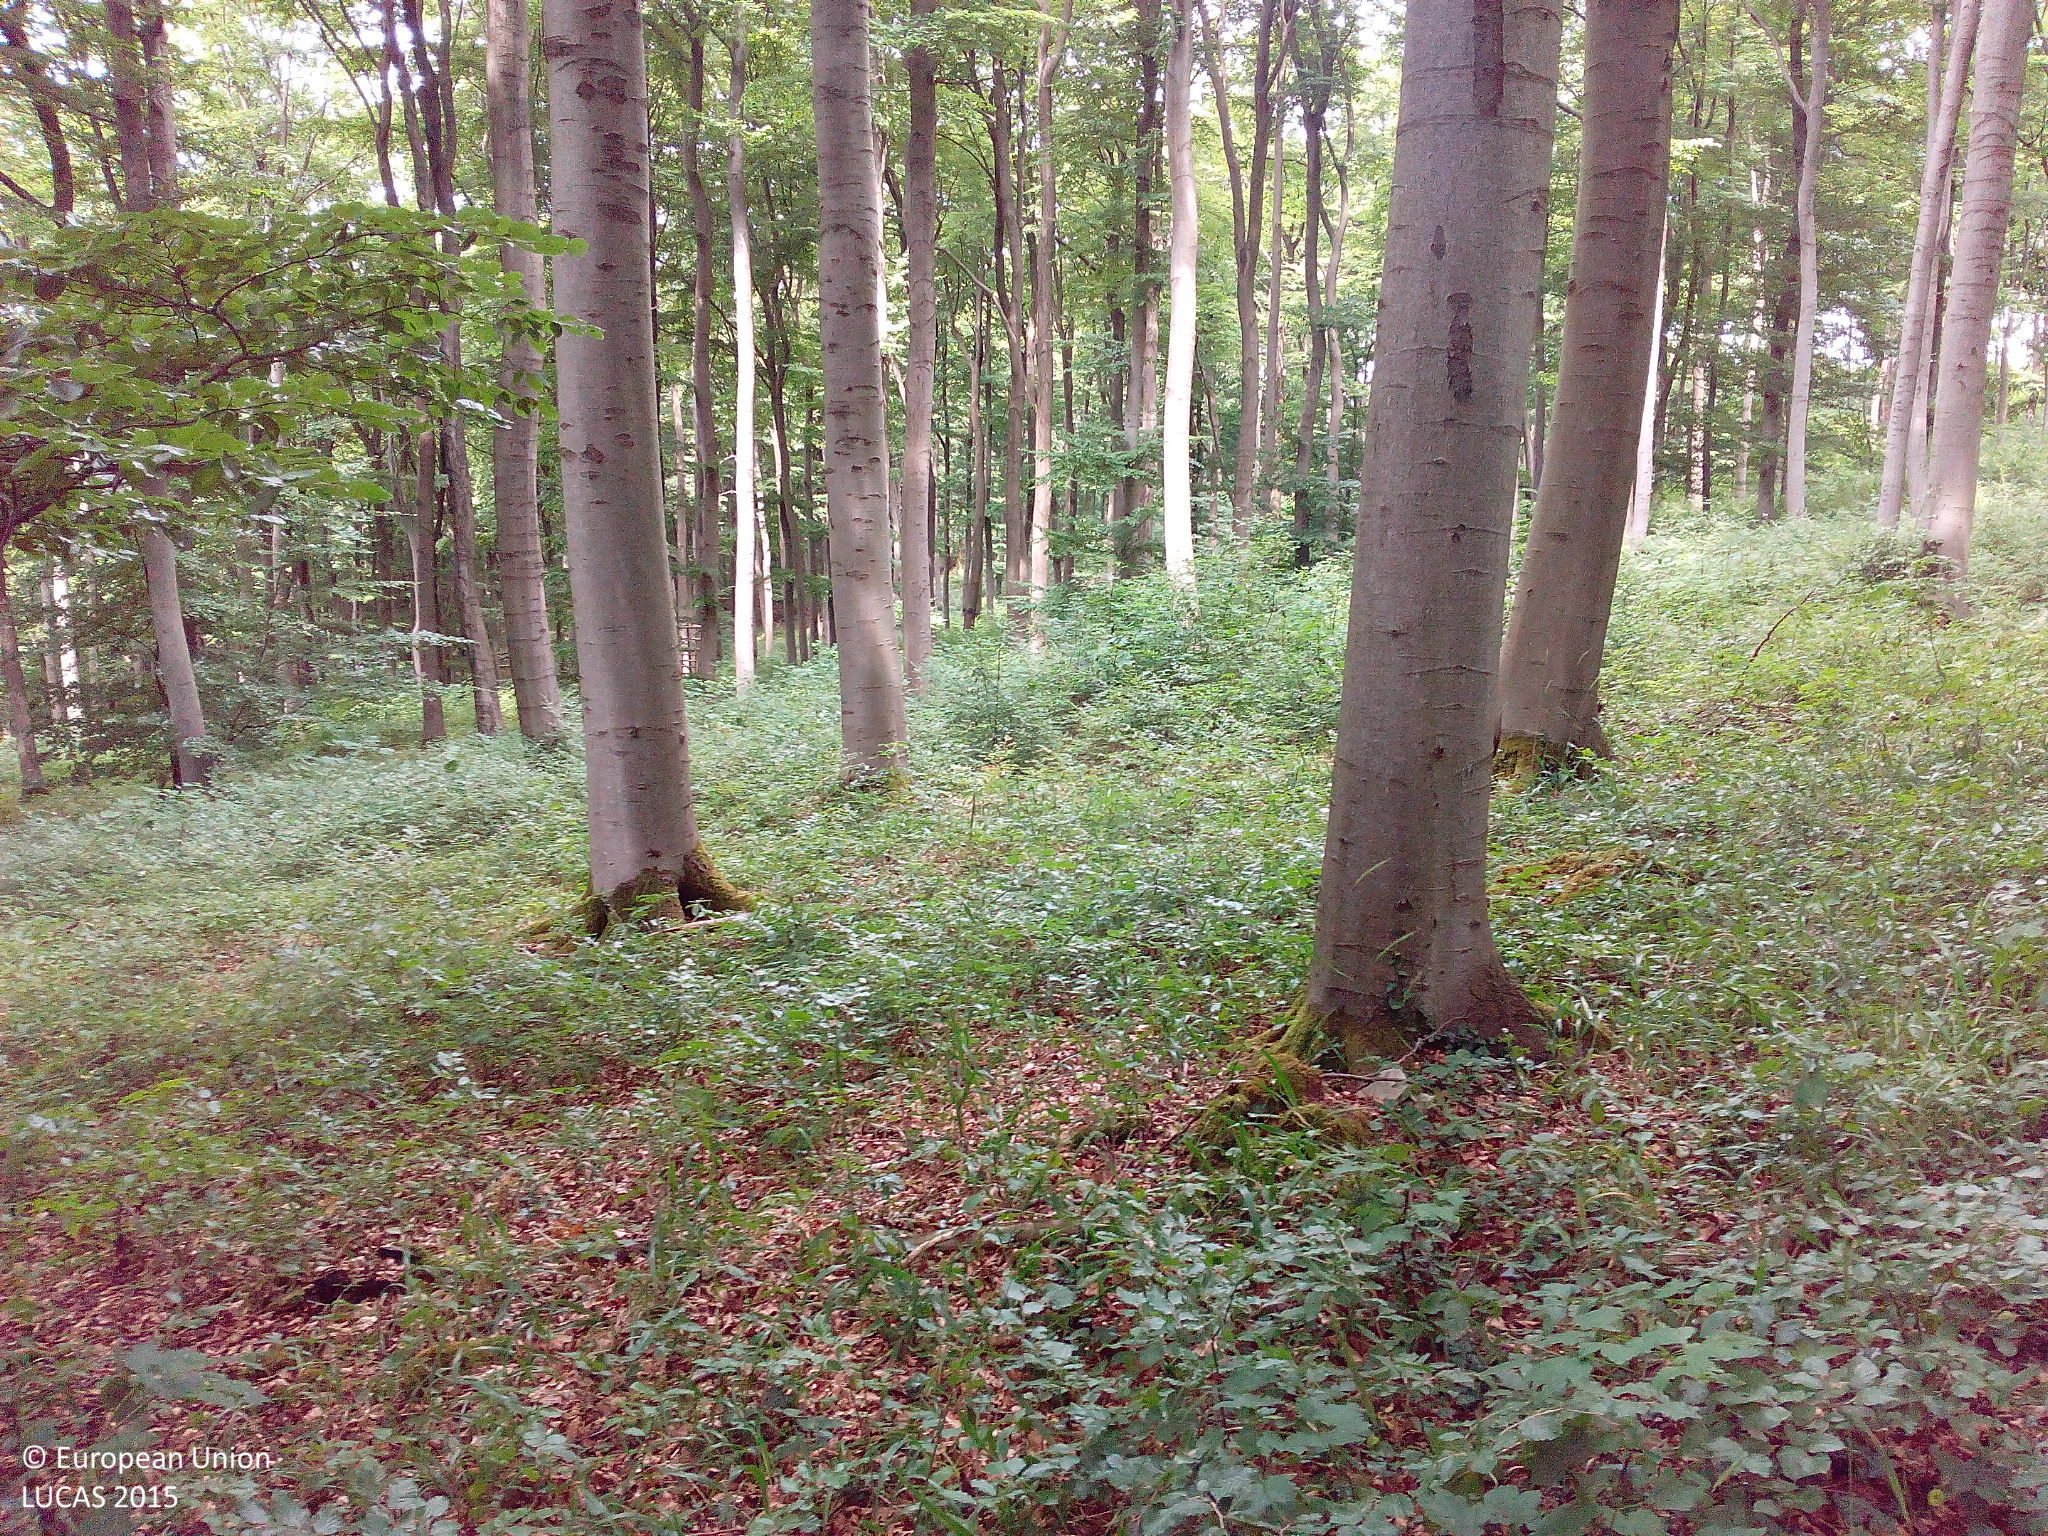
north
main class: Woodland
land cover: Broadleaved woodland
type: beech forest
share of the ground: > 75 %
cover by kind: broadleaved forest trees 90 %, herbaceous plants 10 %
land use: Forestry
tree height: > 5 m
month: July
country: DE
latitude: 50.8314
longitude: 9.8723
